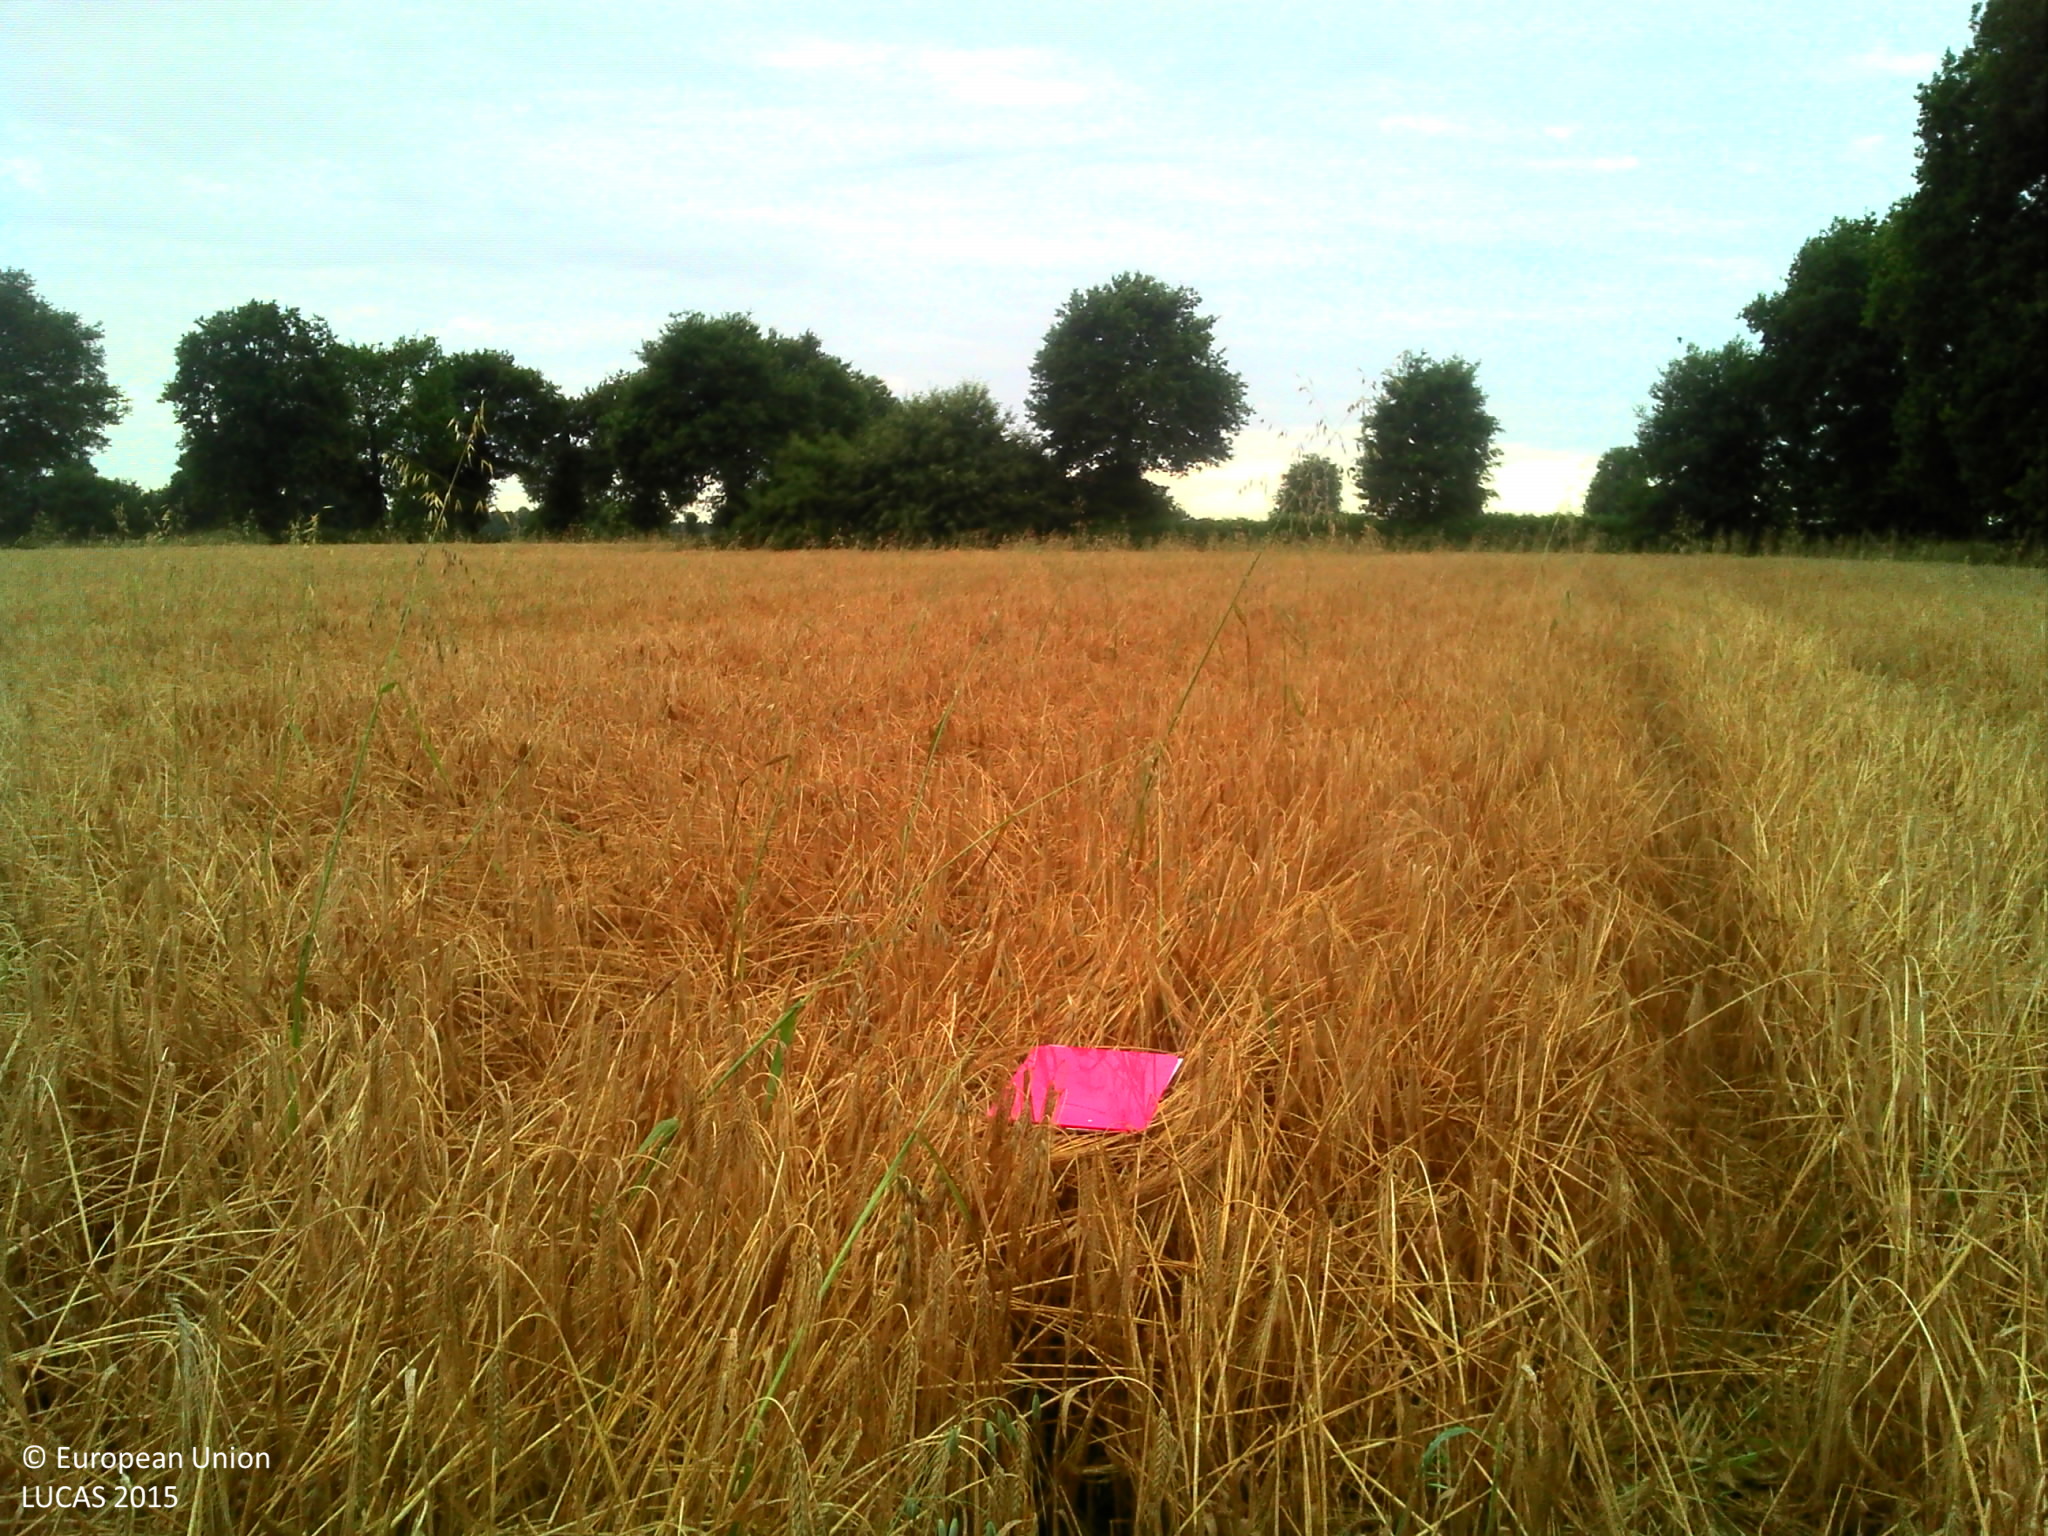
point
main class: Cropland
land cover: Barley
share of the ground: > 75 %
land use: Agriculture (excluding fallow land and kitchen gardens)
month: July
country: FR
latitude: 48.3265
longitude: -1.6889
